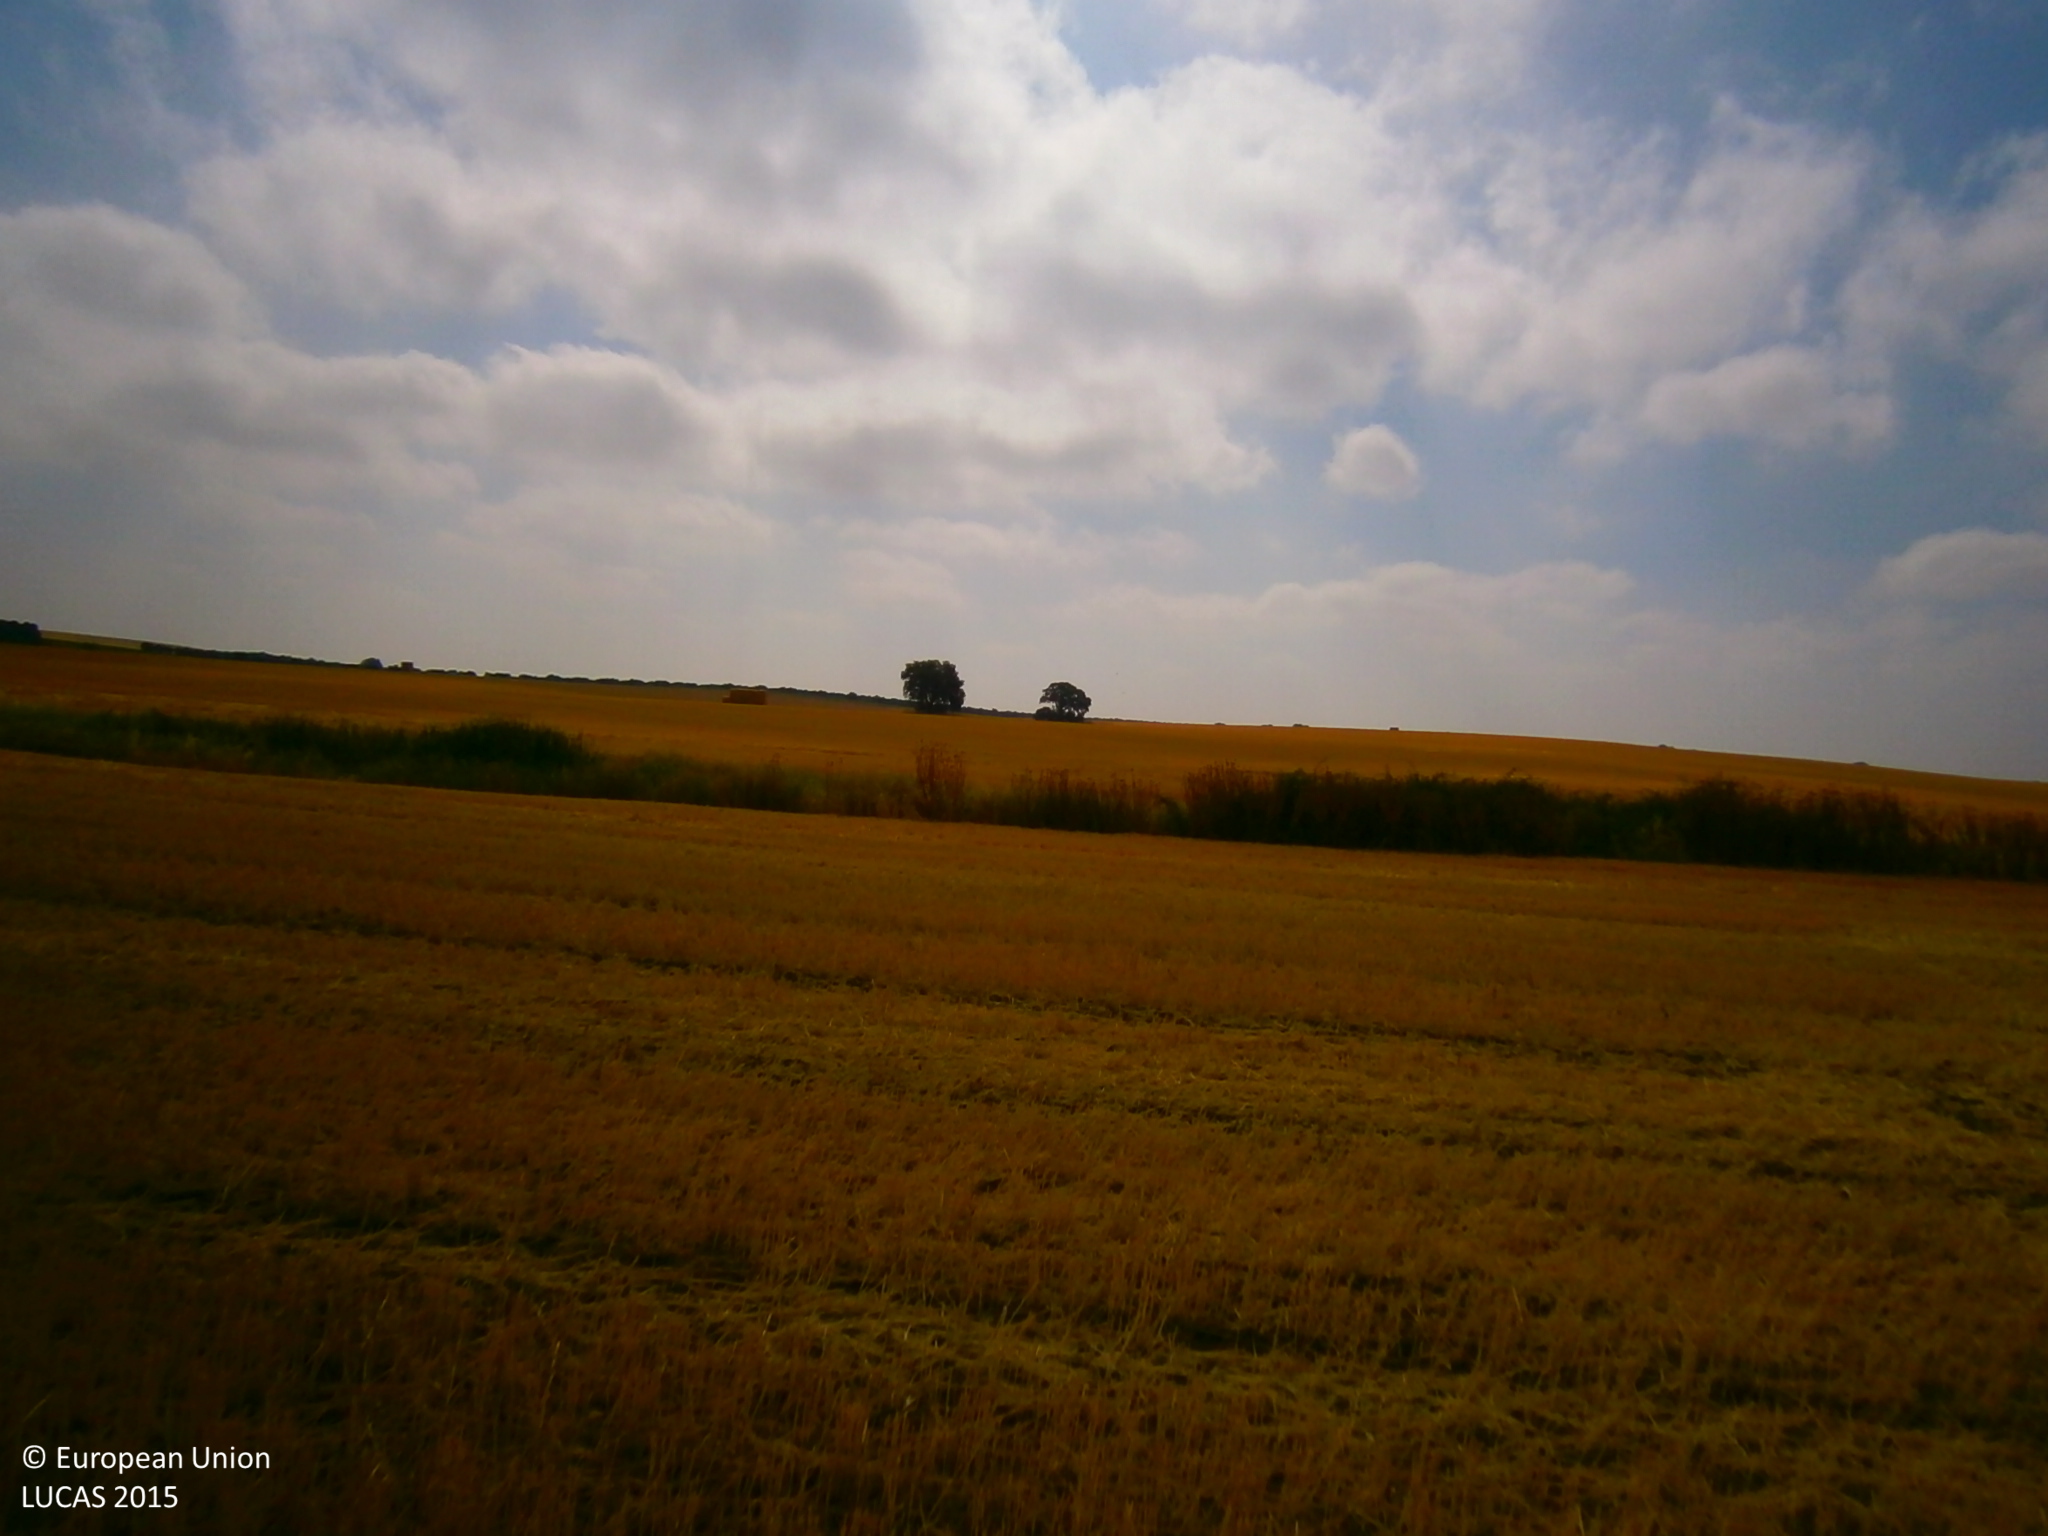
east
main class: Cropland
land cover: Durum wheat
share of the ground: > 75 %
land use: Agriculture (excluding fallow land and kitchen gardens)
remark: Harvested field
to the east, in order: Durum wheat; Rivers and streams; Durum wheat
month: July
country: ES
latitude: 38.7226
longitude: -6.9631
